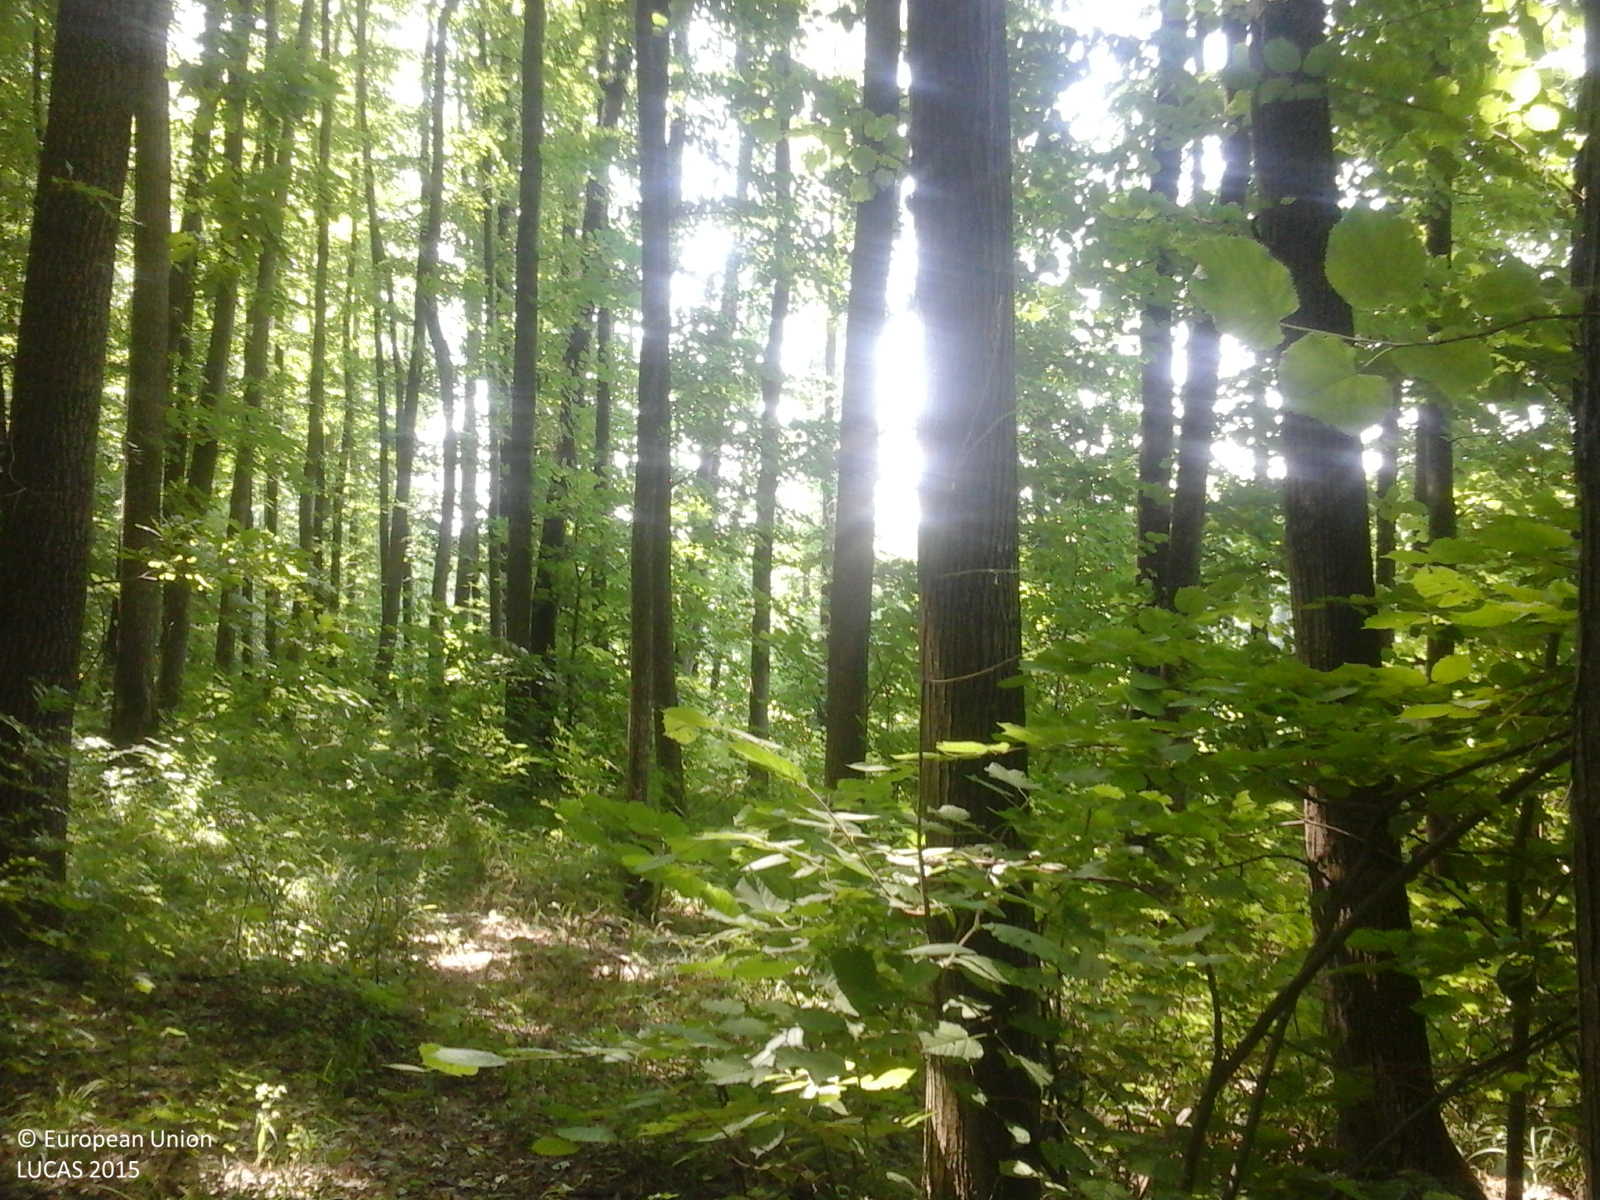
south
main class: Woodland
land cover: Broadleaved woodland
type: beech forest
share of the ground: > 75 %
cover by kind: broadleaved forest trees 95 %, herbaceous plants 5 %
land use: Forestry
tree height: > 5 m
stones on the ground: < 10 %
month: June
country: RO
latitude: 46.9376
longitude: 27.2759
